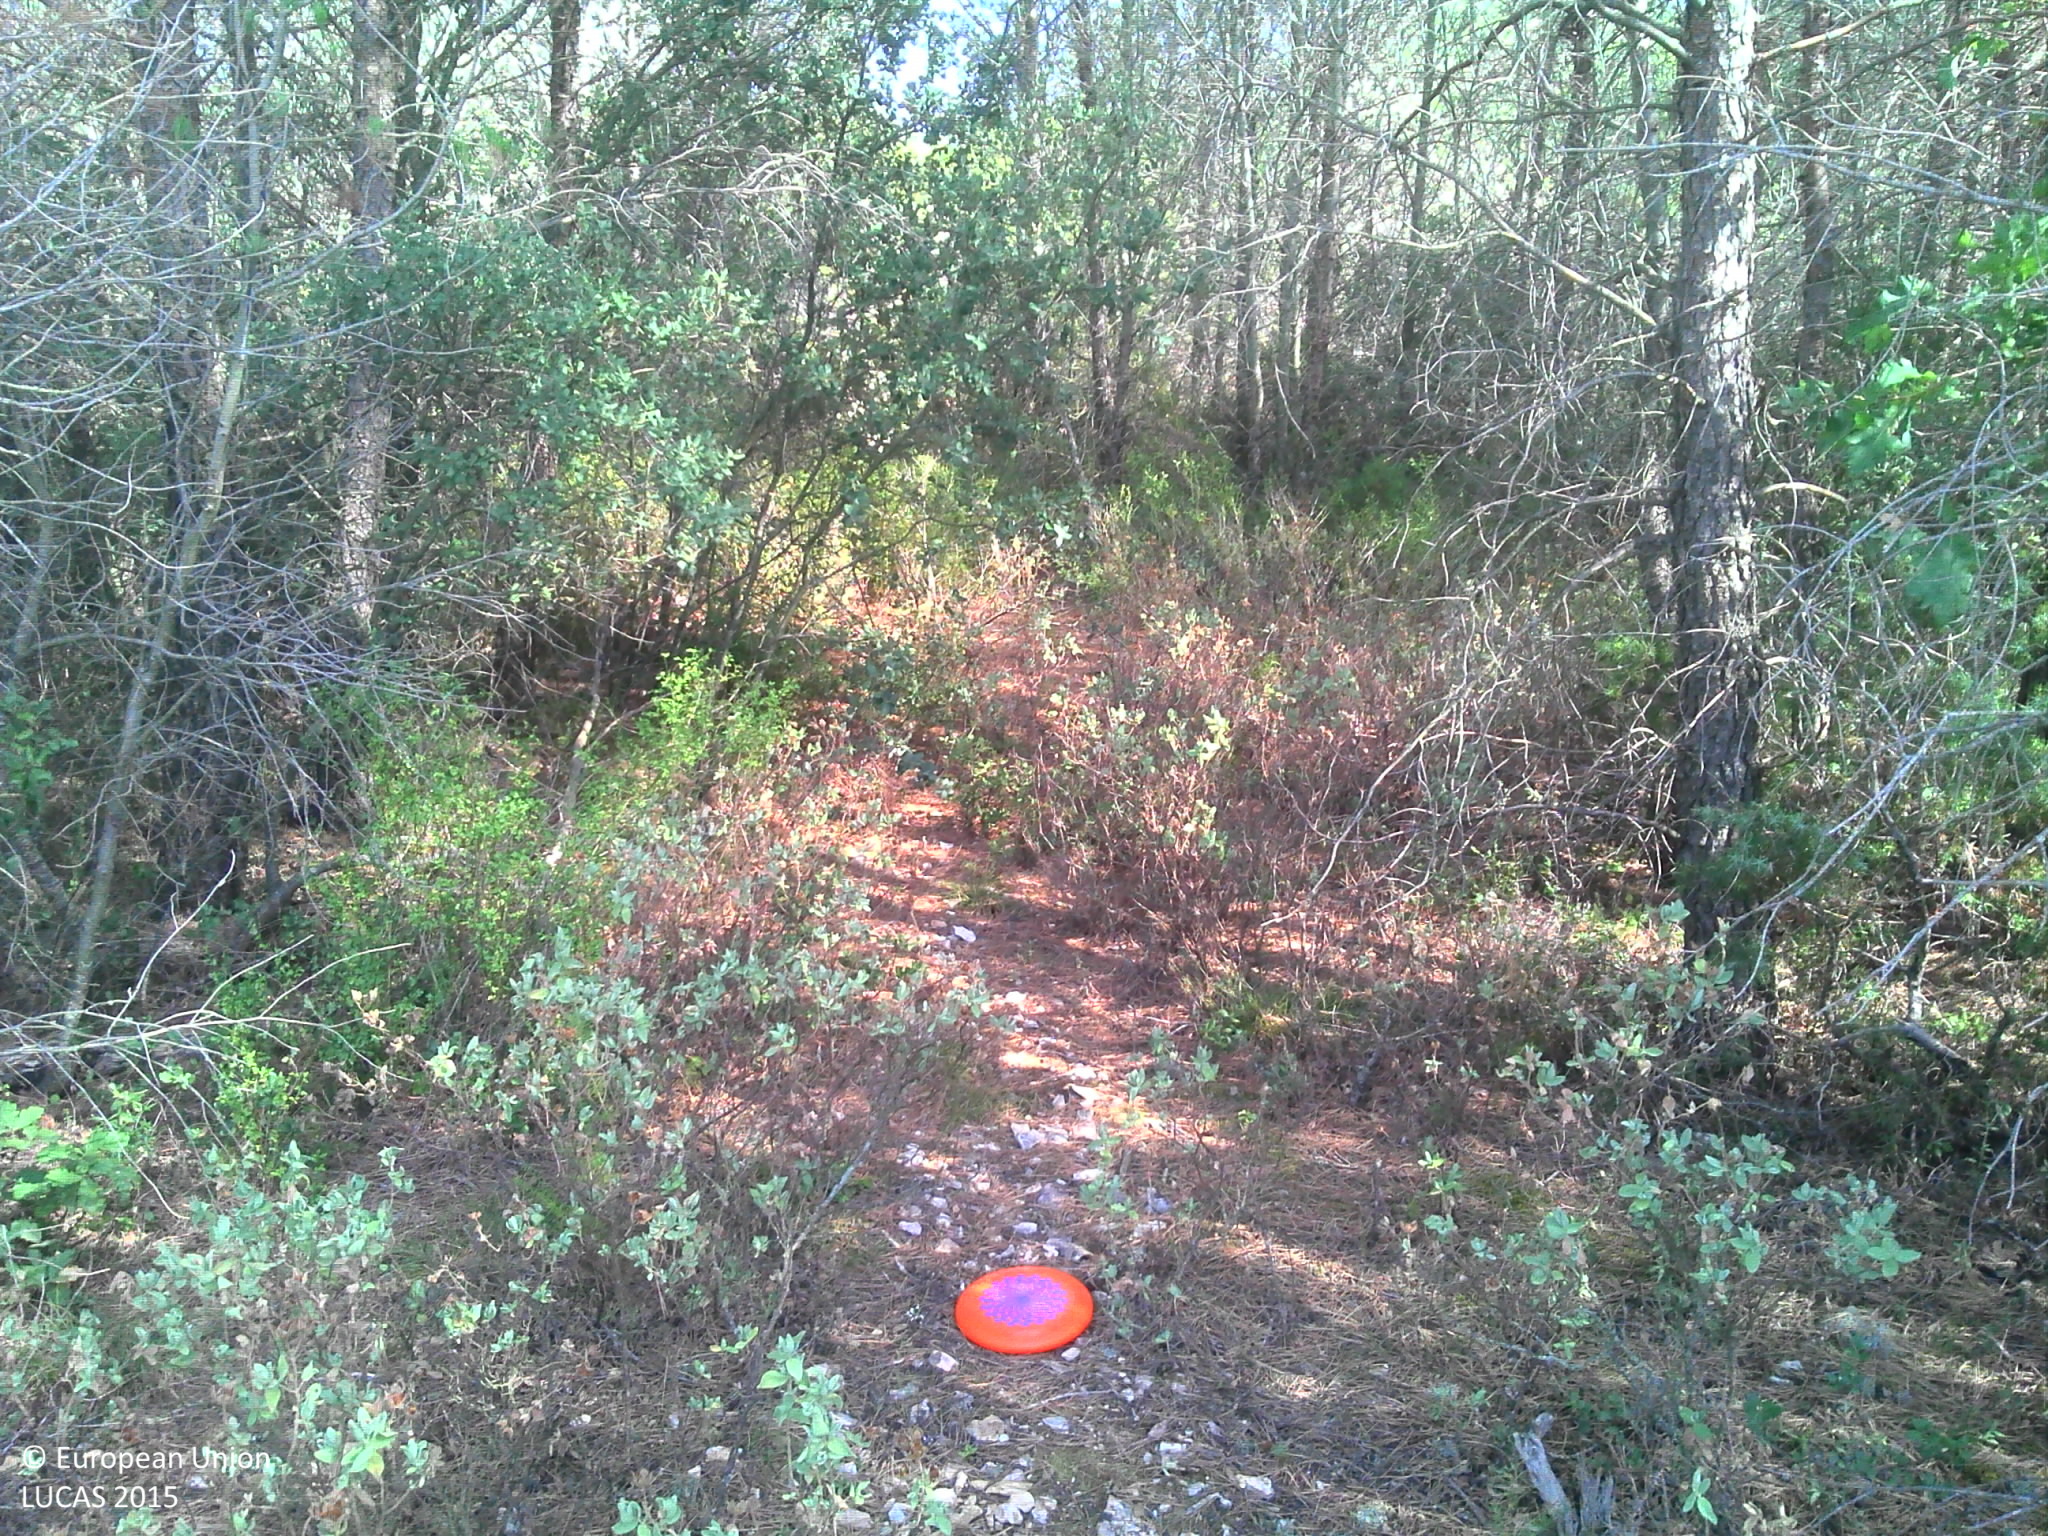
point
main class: Woodland
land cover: Pine dominated coniferous woodland
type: coniferous forest of the mediterranean region
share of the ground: > 75 %
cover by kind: coniferous forest trees 85 %, broadleaved forest trees 5 %, shrubs 5 %, herbaceous plants 5 %
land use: Forestry
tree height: > 5 m
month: August
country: FR
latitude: 43.5920
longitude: 5.2656
